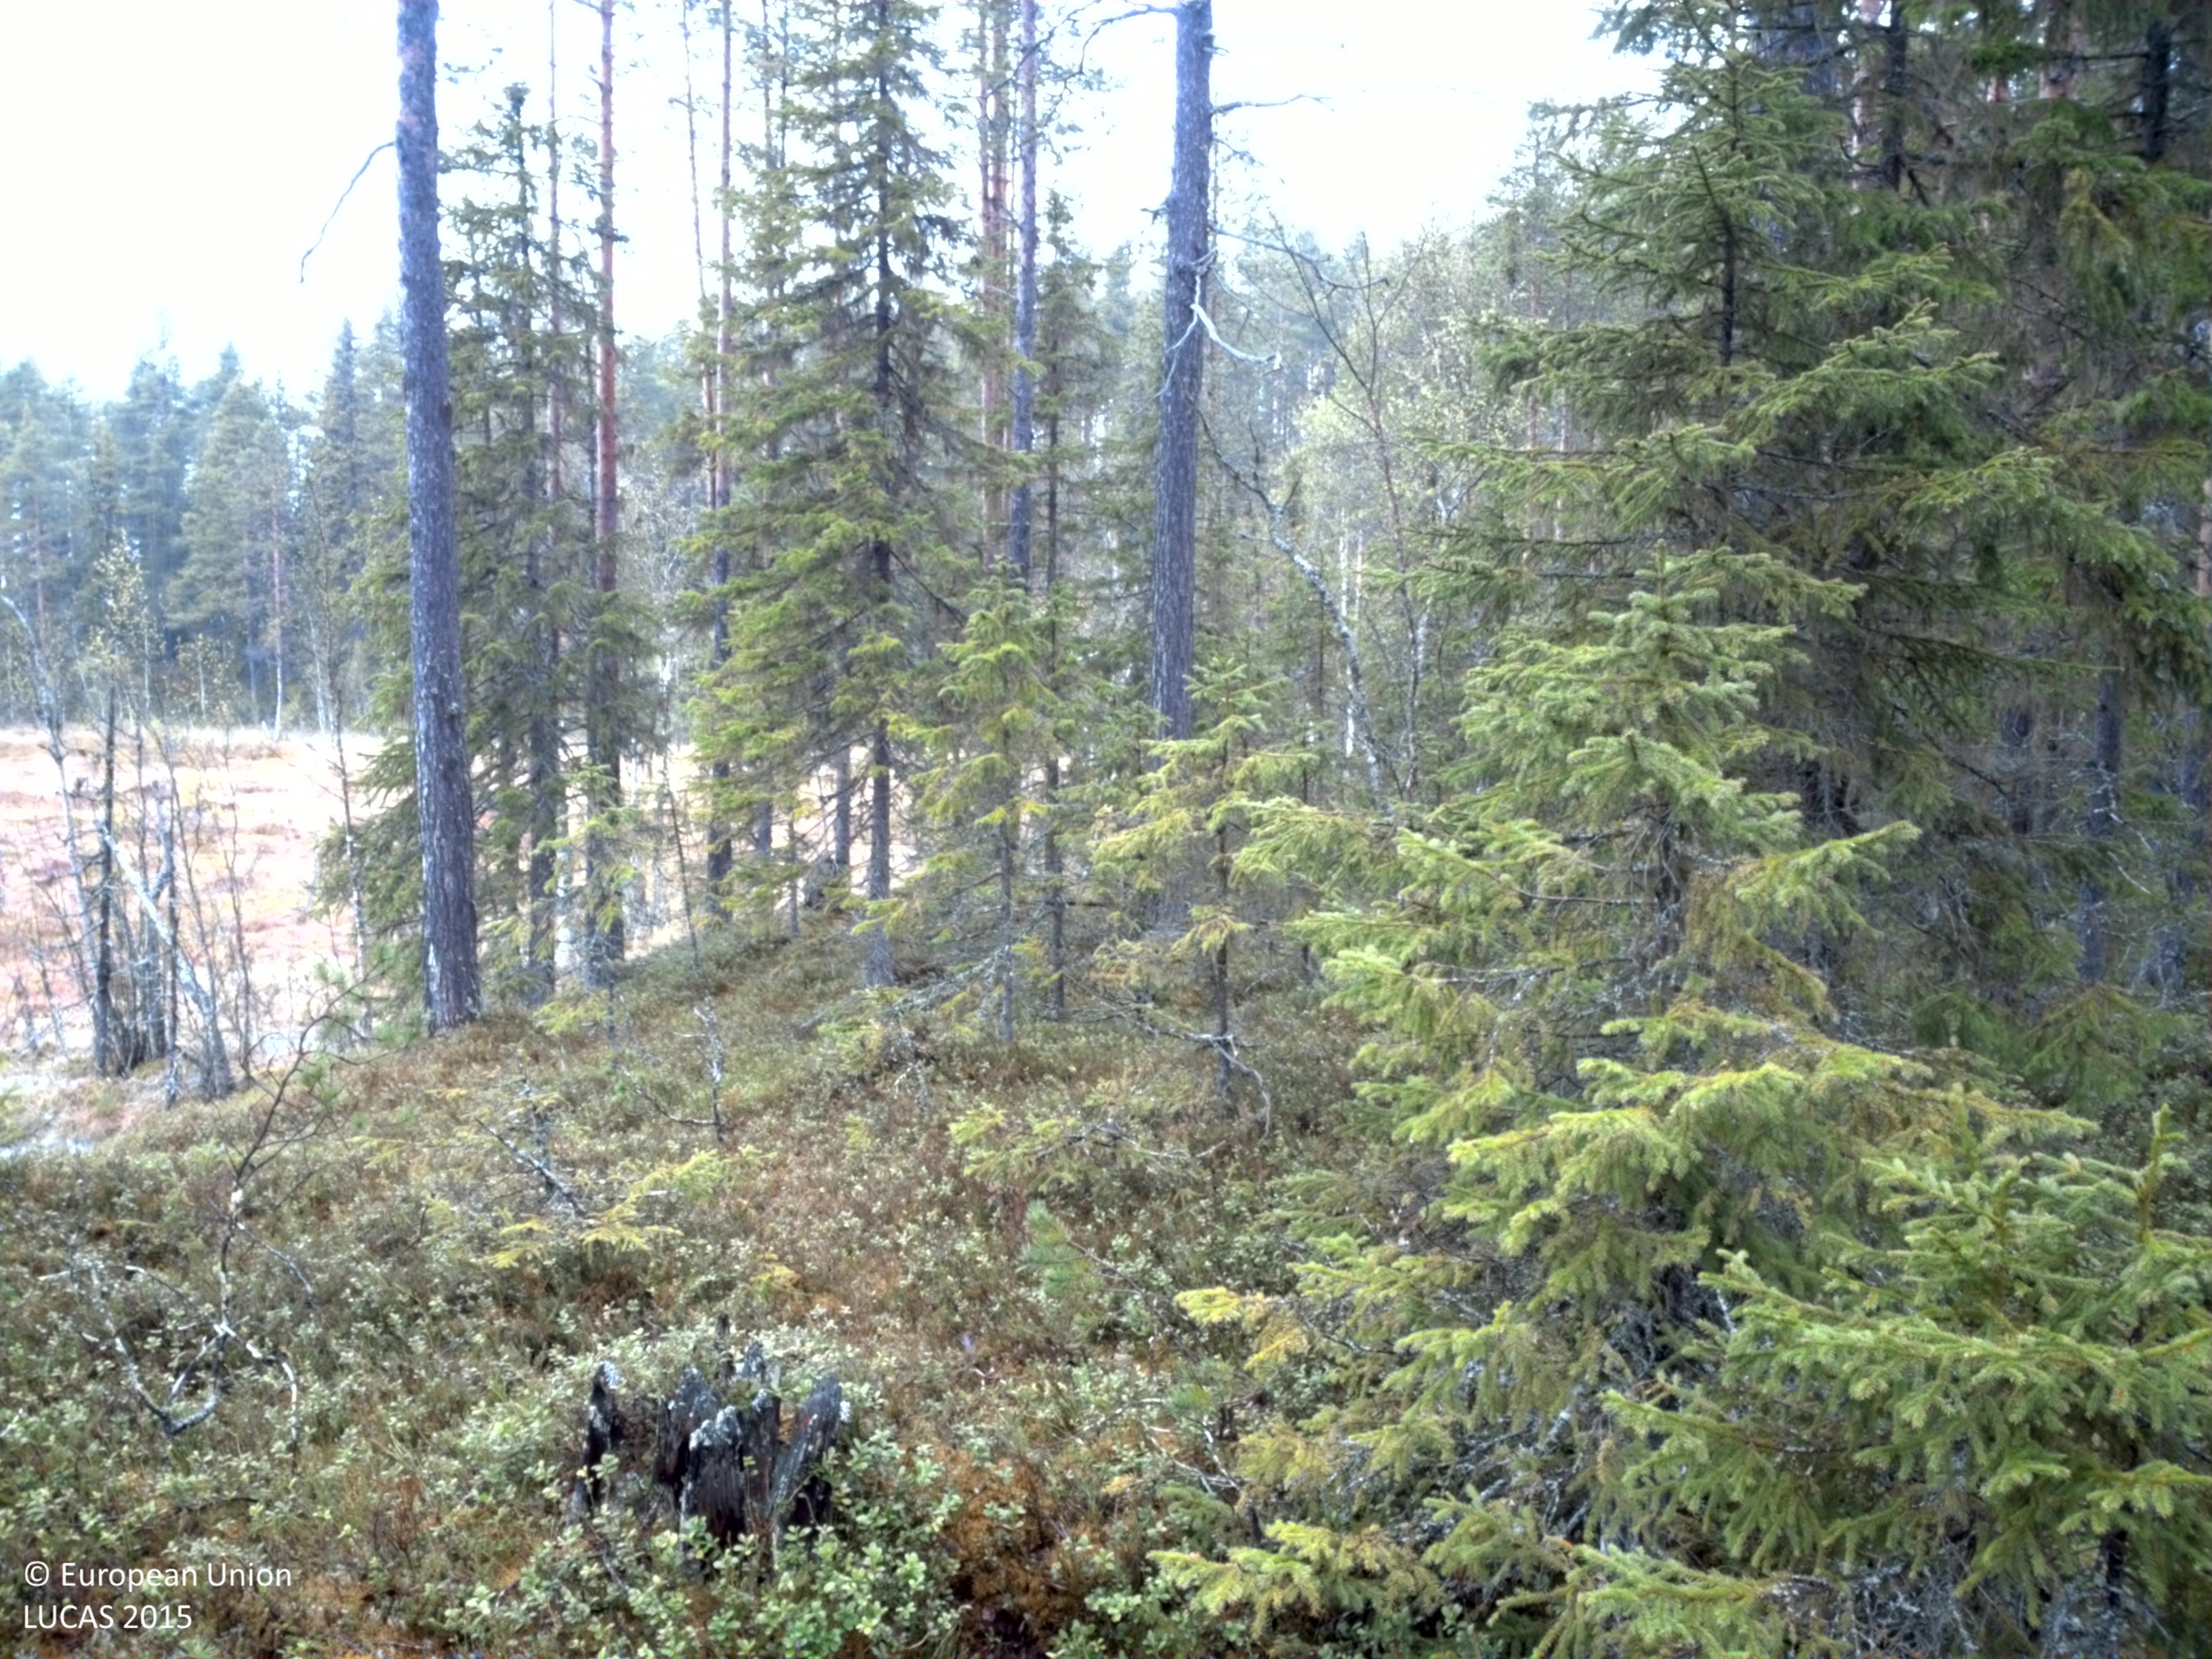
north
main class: Woodland
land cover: Pine dominated coniferous woodland
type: boreal forest
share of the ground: > 75 %
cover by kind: coniferous forest trees 80 %, broadleaved forest trees 10 %, shrubs 10 %
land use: Forestry
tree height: > 5 m
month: June
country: SE
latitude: 63.3924
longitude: 14.5610
